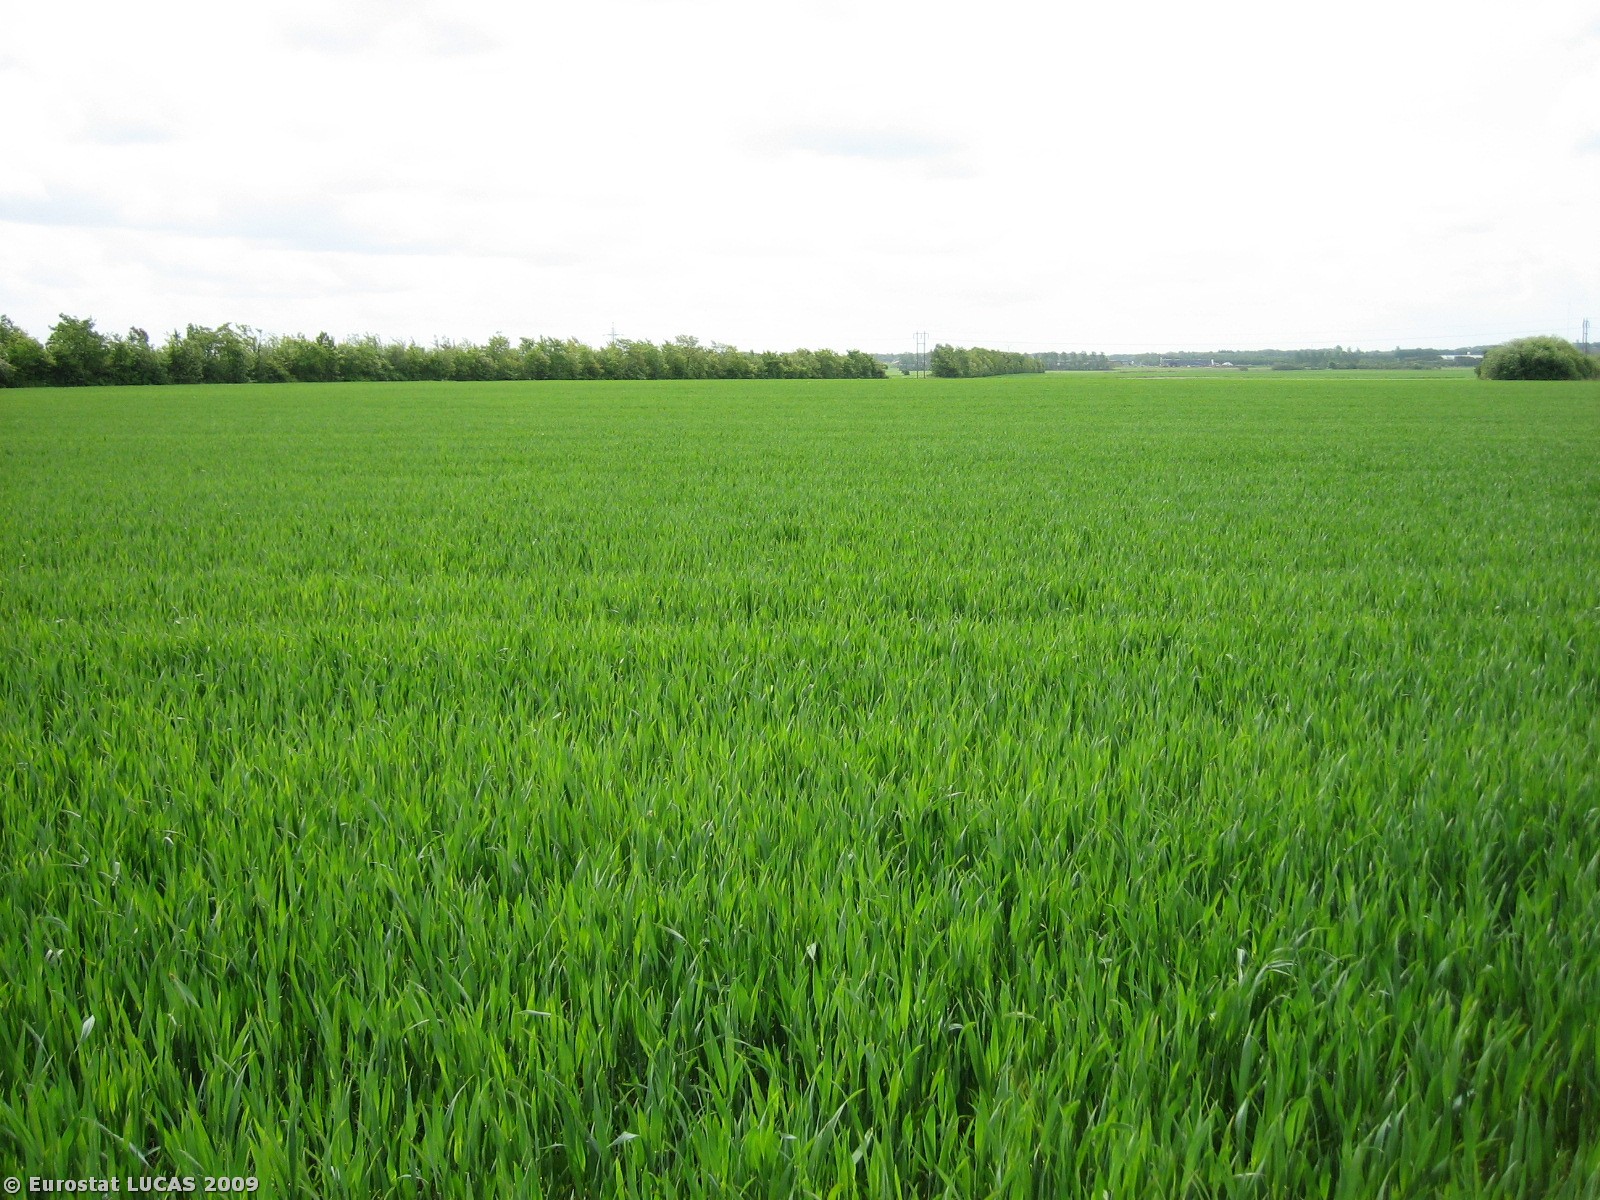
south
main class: Cropland
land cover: Common wheat
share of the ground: > 75 %
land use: Agriculture (excluding fallow land and kitchen gardens)
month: May
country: DK
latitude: 56.2180
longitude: 8.7920
